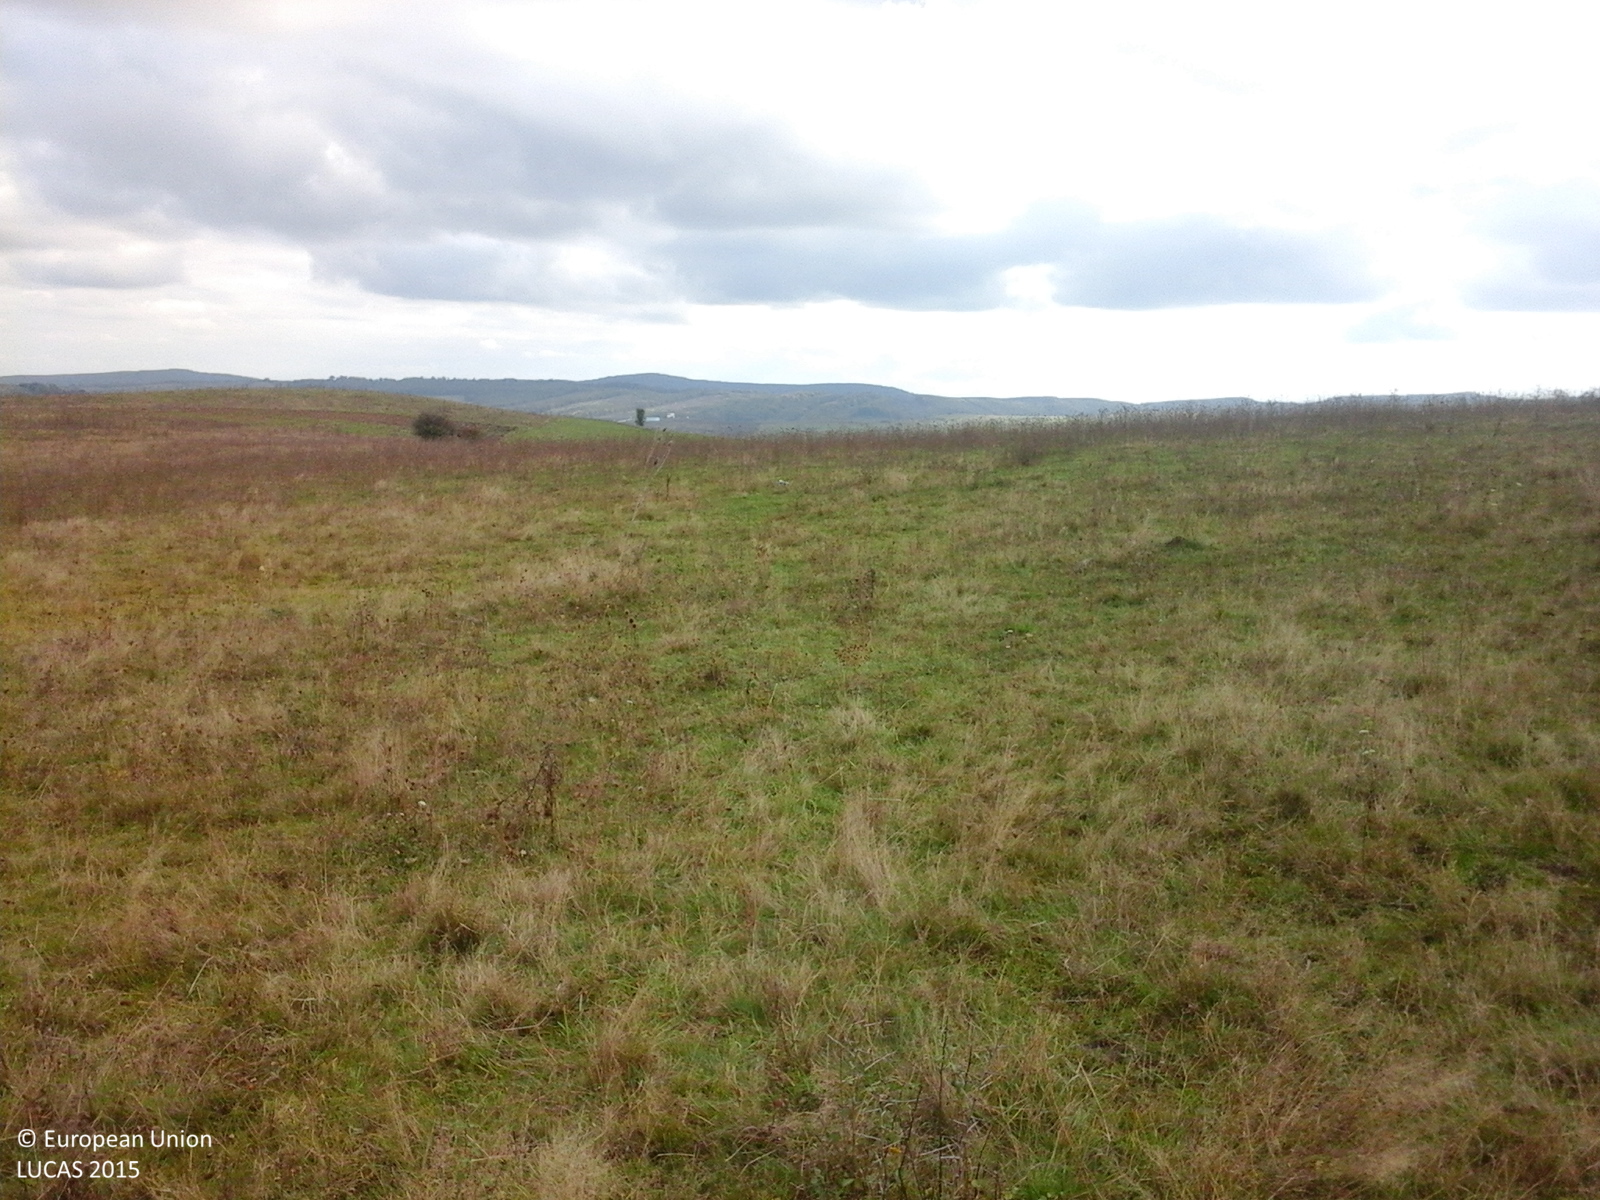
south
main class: Grassland
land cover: Grassland without tree/shrub cover
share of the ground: > 75 %
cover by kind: herbaceous plants 100 %
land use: Agriculture (excluding fallow land and kitchen gardens)
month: October
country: RO
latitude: 45.9820
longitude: 24.6071
